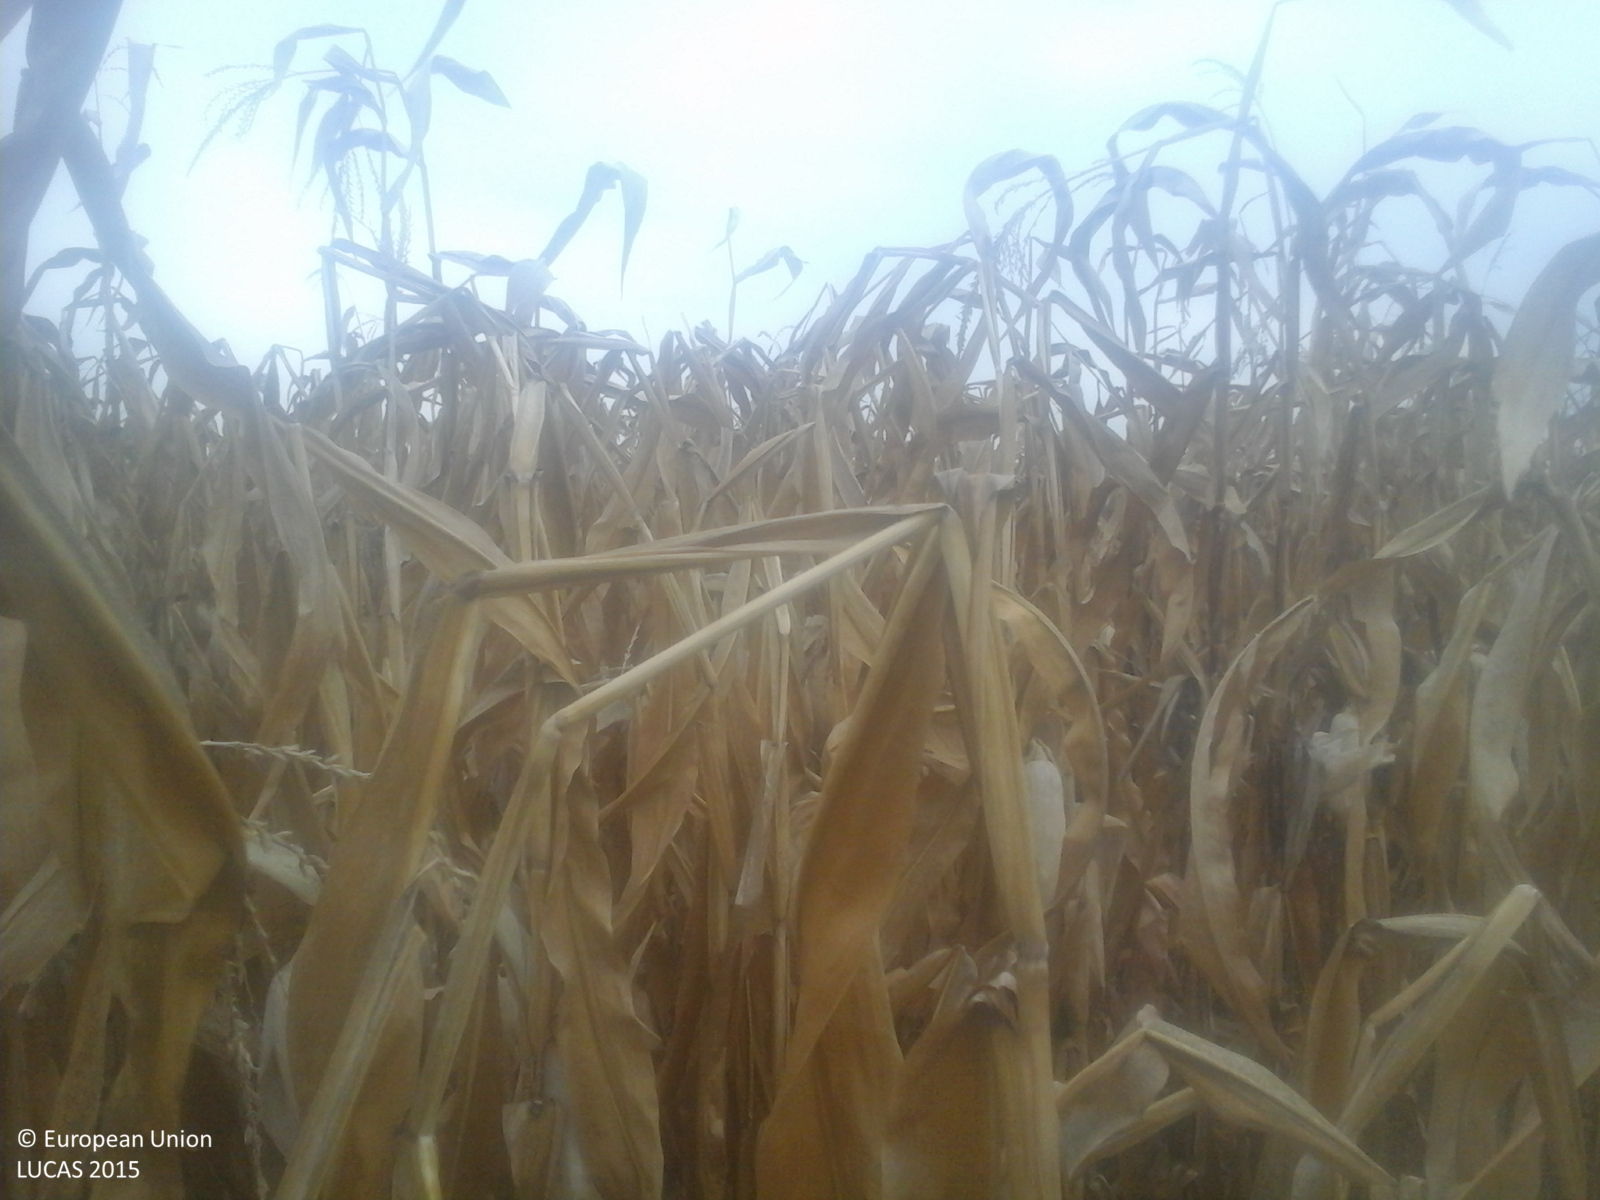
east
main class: Cropland
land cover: Maize
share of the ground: > 75 %
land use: Agriculture (excluding fallow land and kitchen gardens)
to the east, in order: Maize
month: September
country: RO
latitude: 47.6213
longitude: 22.4715
